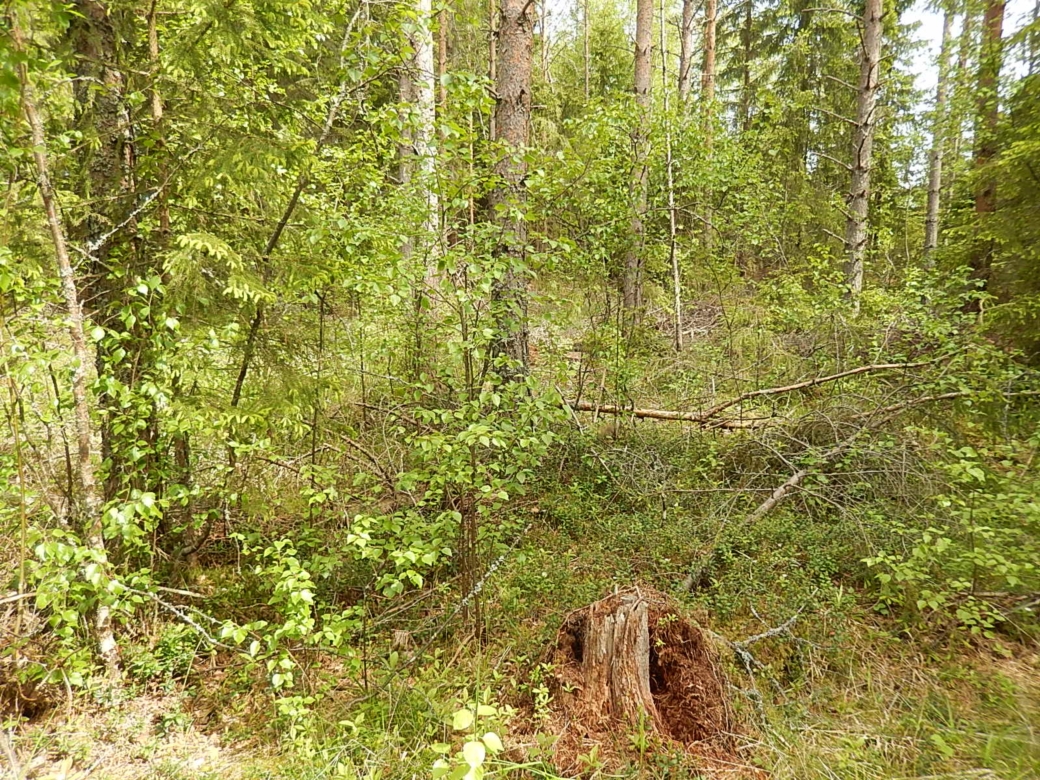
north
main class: Woodland
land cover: Other coniferous woodland
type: boreal forest
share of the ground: > 75 %
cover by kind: coniferous forest trees 70 %, broadleaved forest trees 10 %, shrubs 10 %, herbaceous plants 10 %
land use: Forestry
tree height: > 5 m
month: June
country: FI
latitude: 61.9155
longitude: 21.4912
